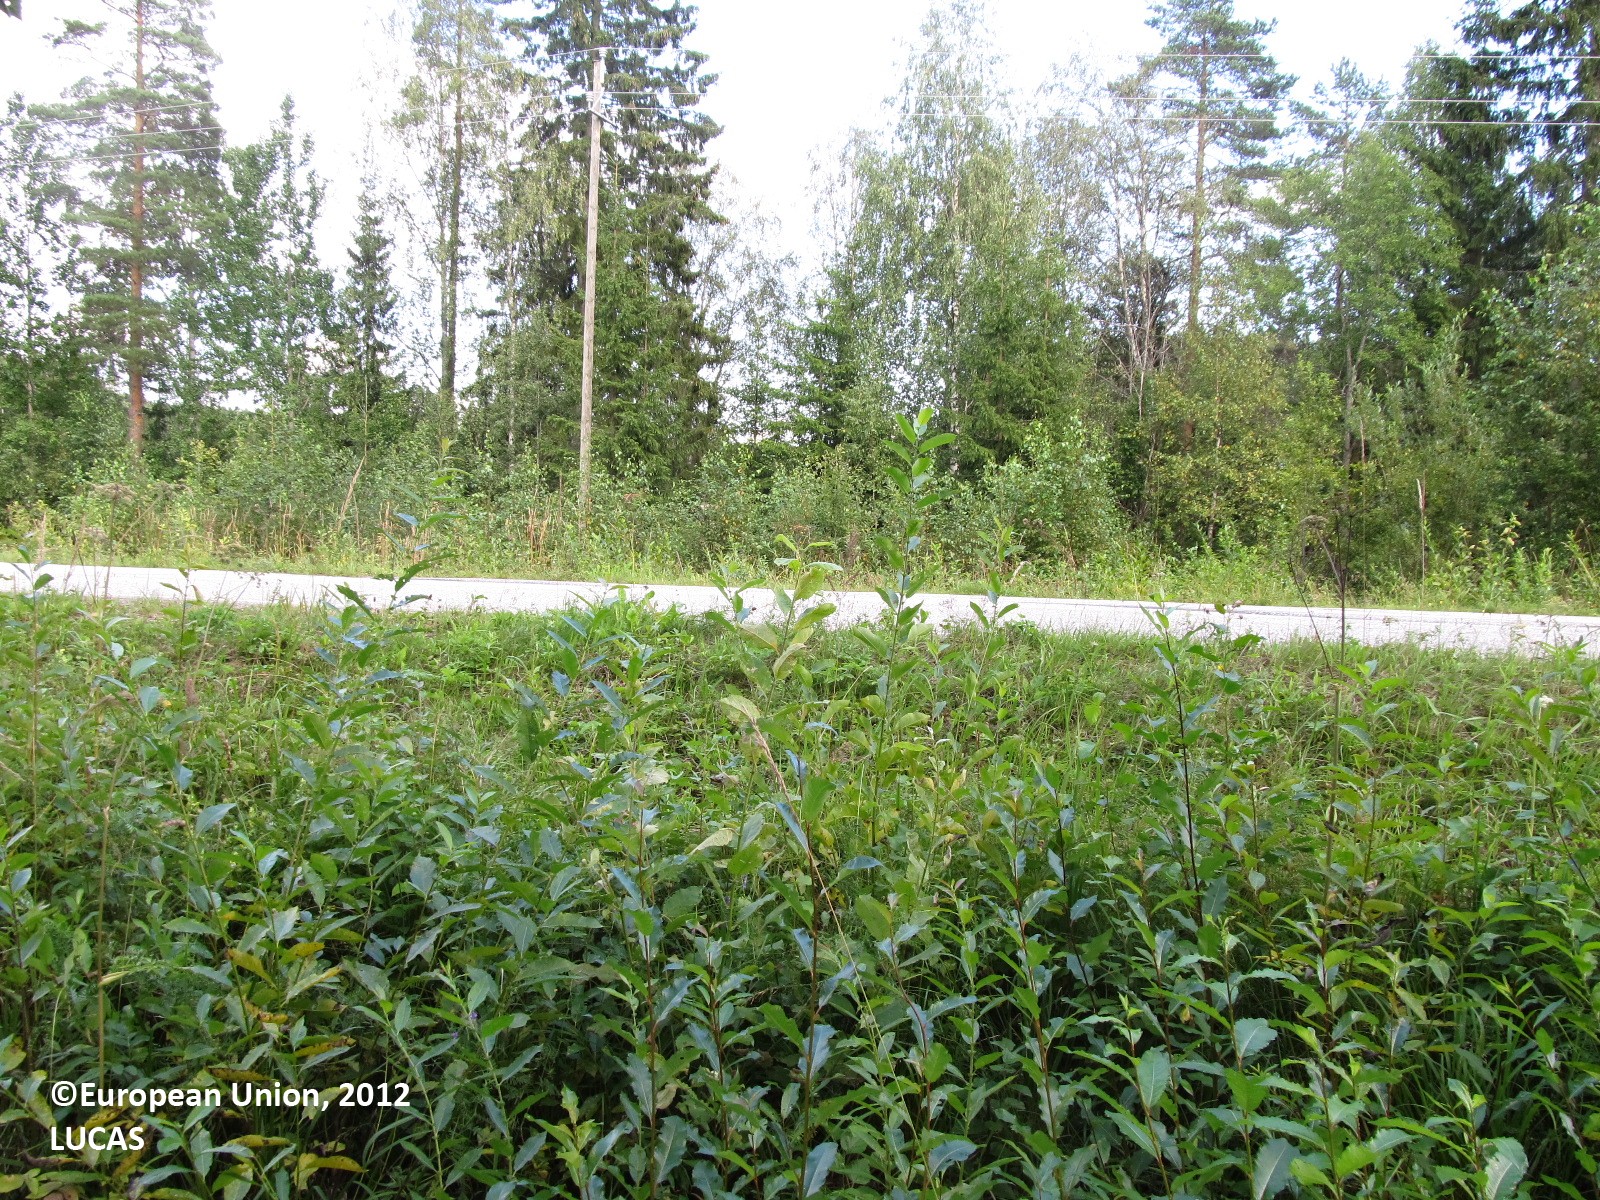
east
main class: Woodland
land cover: Pine dominated mixed woodland
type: boreal forest
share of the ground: 50 - 75 %
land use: Forestry
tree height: > 5 m
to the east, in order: Pine dominated mixed woodland; Broadleaved woodland; Ditches and canals; Grass margins; Paved roads, cycling and walking lanes; Grass margins; Ditches and canals; Electric lines; Pine dominated mixed woodland; Barley; Tracks
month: August
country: FI
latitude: 62.3108
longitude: 28.3103
